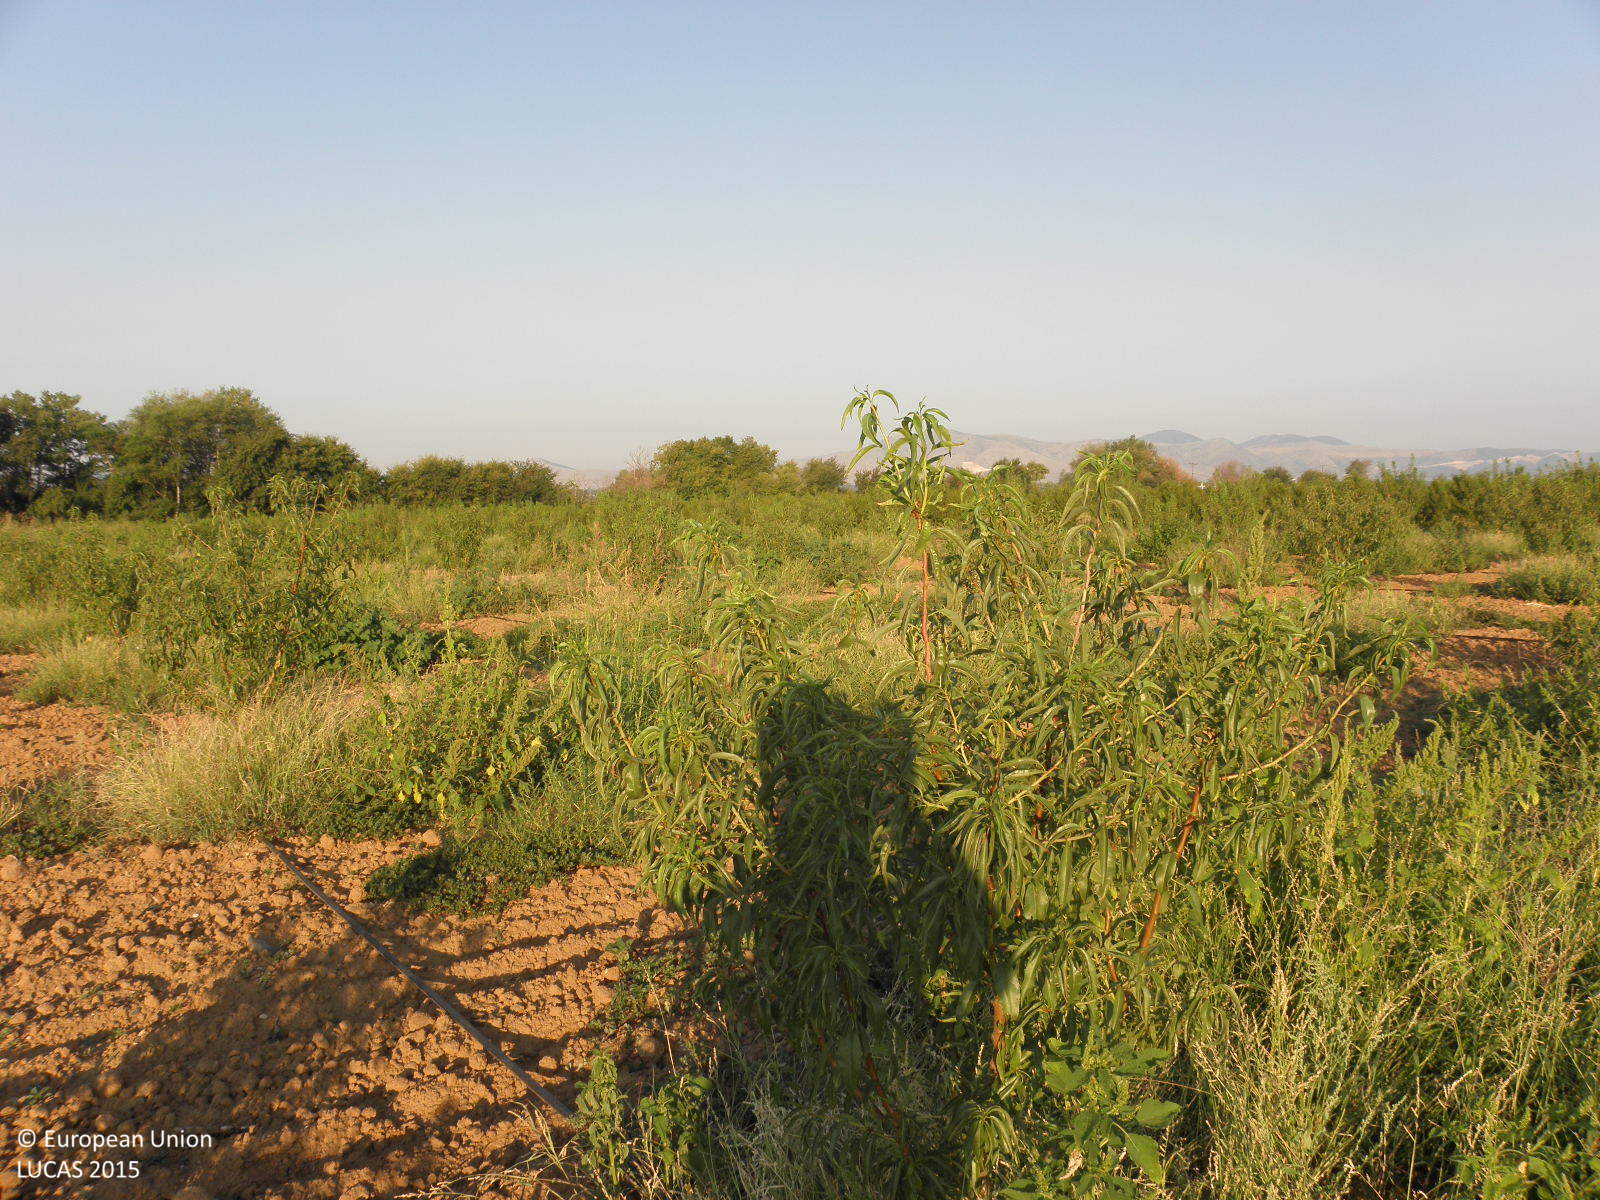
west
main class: Cropland
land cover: Nuts trees
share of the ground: 10 - 25 %
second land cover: Spontaneously vegetated surfaces
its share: 50 - 75 %
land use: Agriculture (excluding fallow land and kitchen gardens)
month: August
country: GR
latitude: 39.7669
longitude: 22.4239
